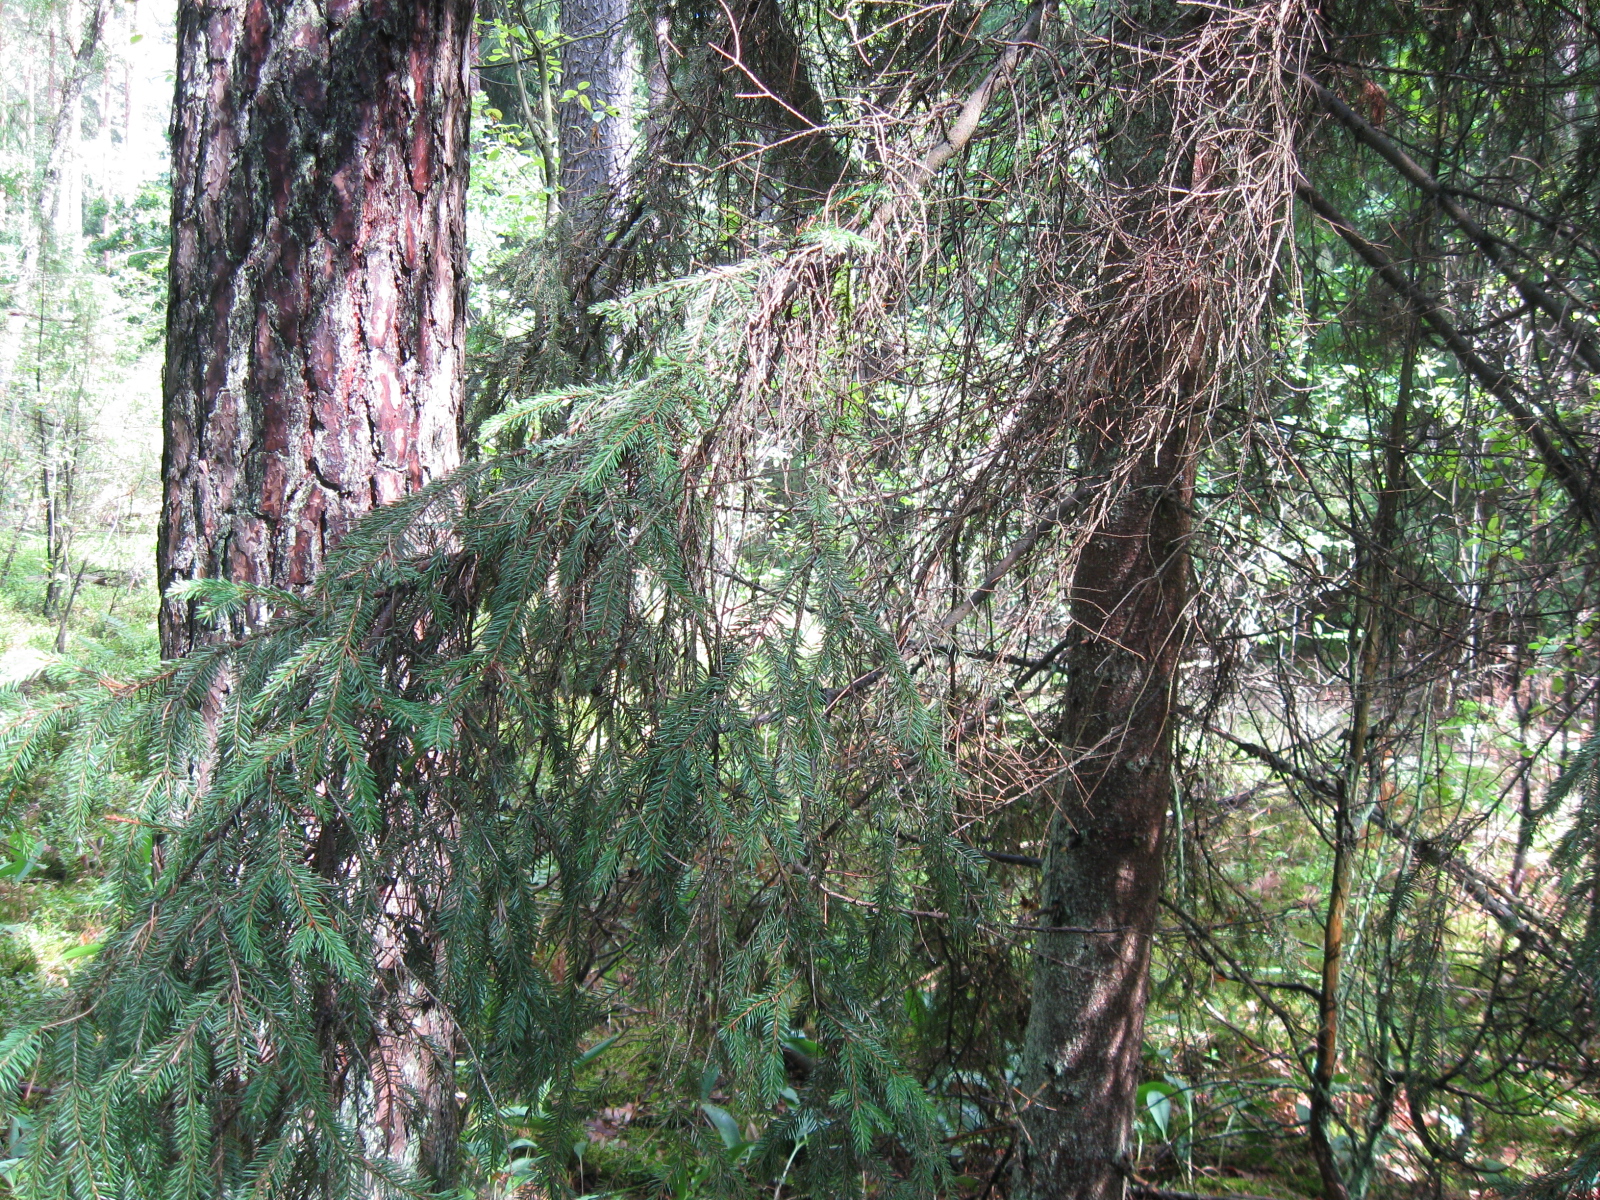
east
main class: Woodland
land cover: Other coniferous woodland
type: hemiboreal forest and nemoral coniferous forest and mixed broadleaved-coniferous forest
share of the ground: > 75 %
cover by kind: coniferous forest trees 80 %, lichens and mosses 10 %, broadleaved forest trees 5 %, herbaceous plants 5 %
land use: Forestry
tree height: > 5 m
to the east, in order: Other coniferous woodland; Tracks; Pine dominated coniferous woodland; Pine dominated mixed woodland; Tracks; Pine dominated mixed woodland; Pine dominated coniferous woodland
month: July
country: LT
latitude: 53.9582
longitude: 23.6343
